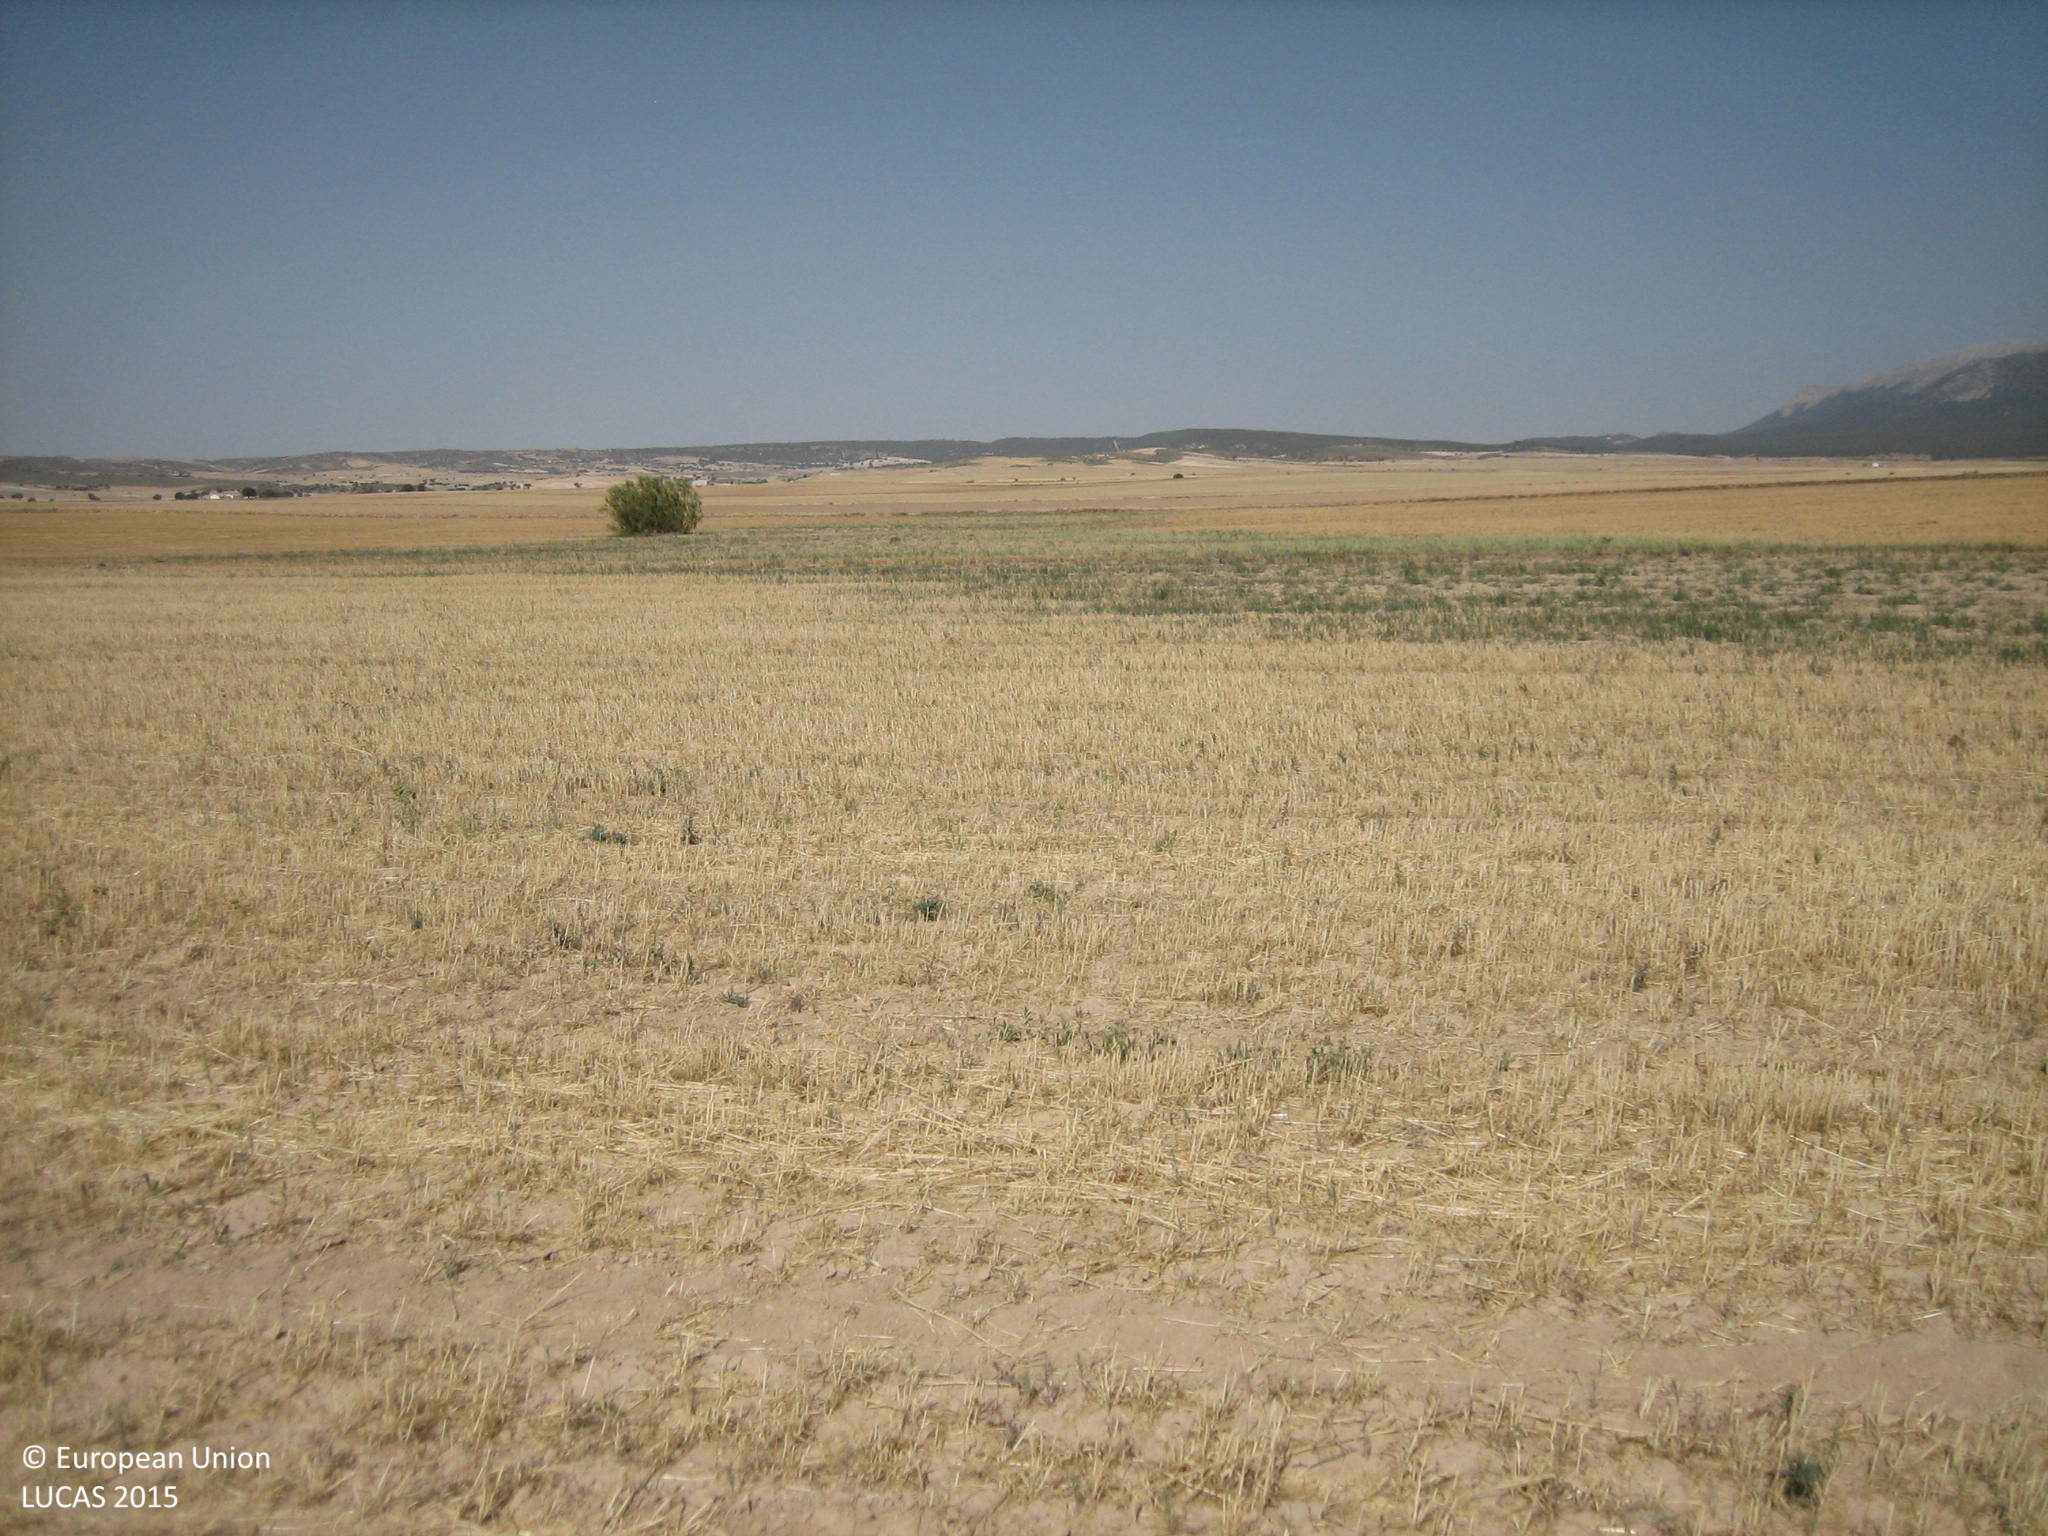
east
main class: Cropland
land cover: Barley
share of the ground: < 10 %
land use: Agriculture (excluding fallow land and kitchen gardens)
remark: Harvested field
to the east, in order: Barley; Grass margins; Barley; Grass margins; Other bare soil
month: July
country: ES
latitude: 37.7100
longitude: -2.3400
